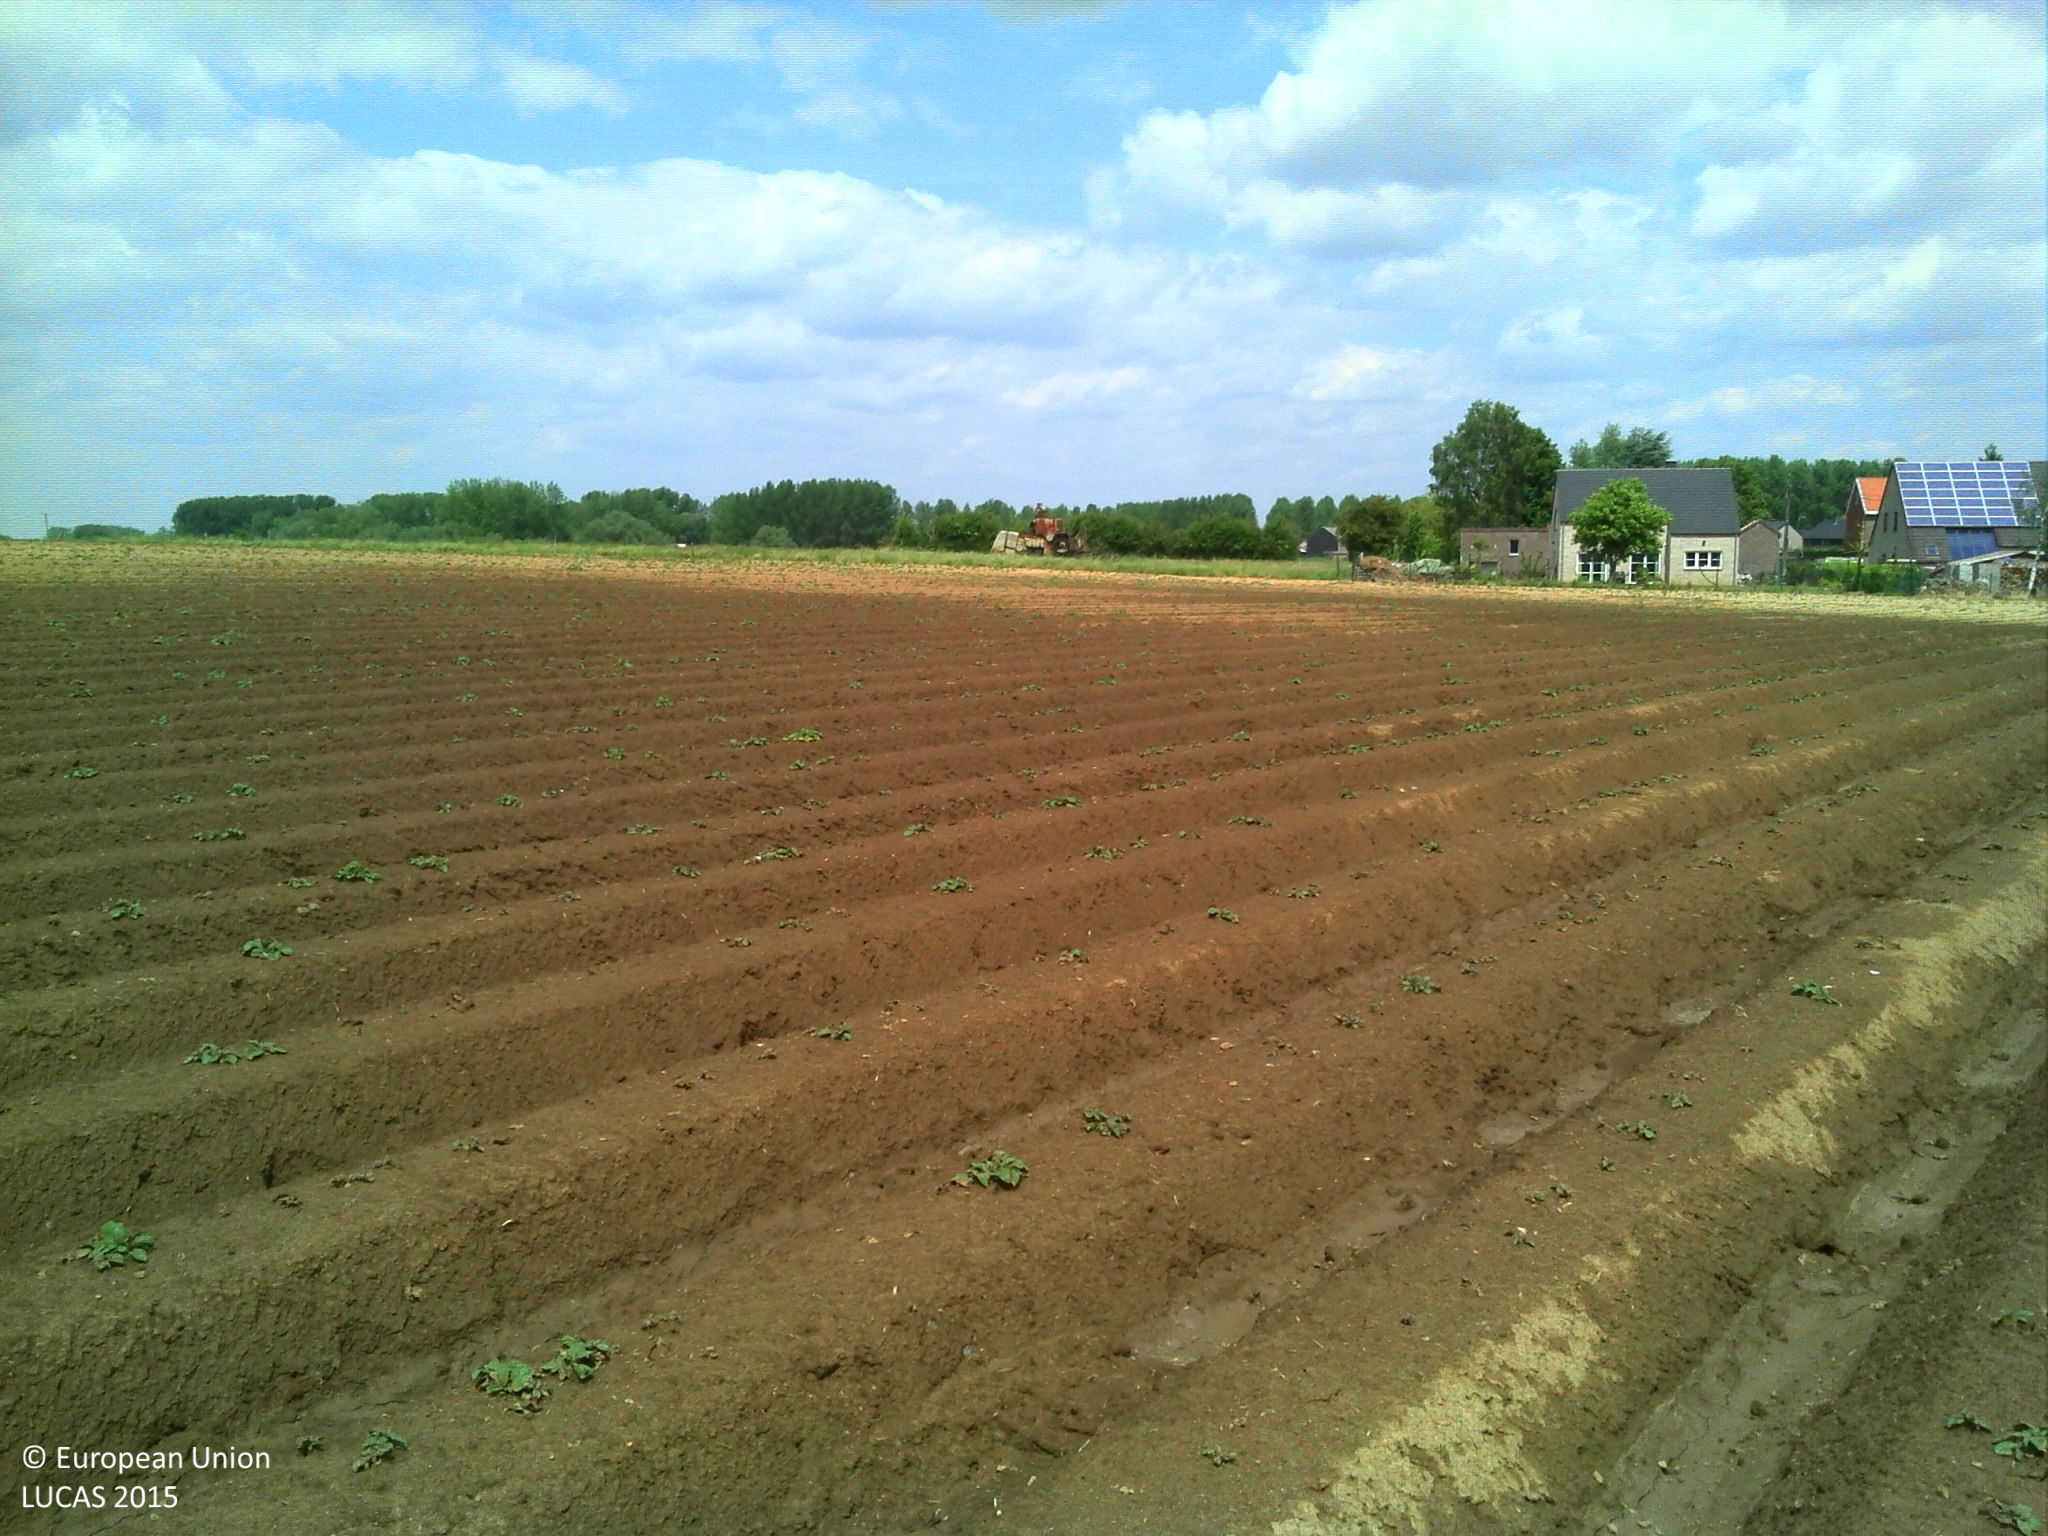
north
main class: Cropland
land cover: Potatoes
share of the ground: < 10 %
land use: Agriculture (excluding fallow land and kitchen gardens)
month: May
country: BE
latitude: 50.6585
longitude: 5.1738
